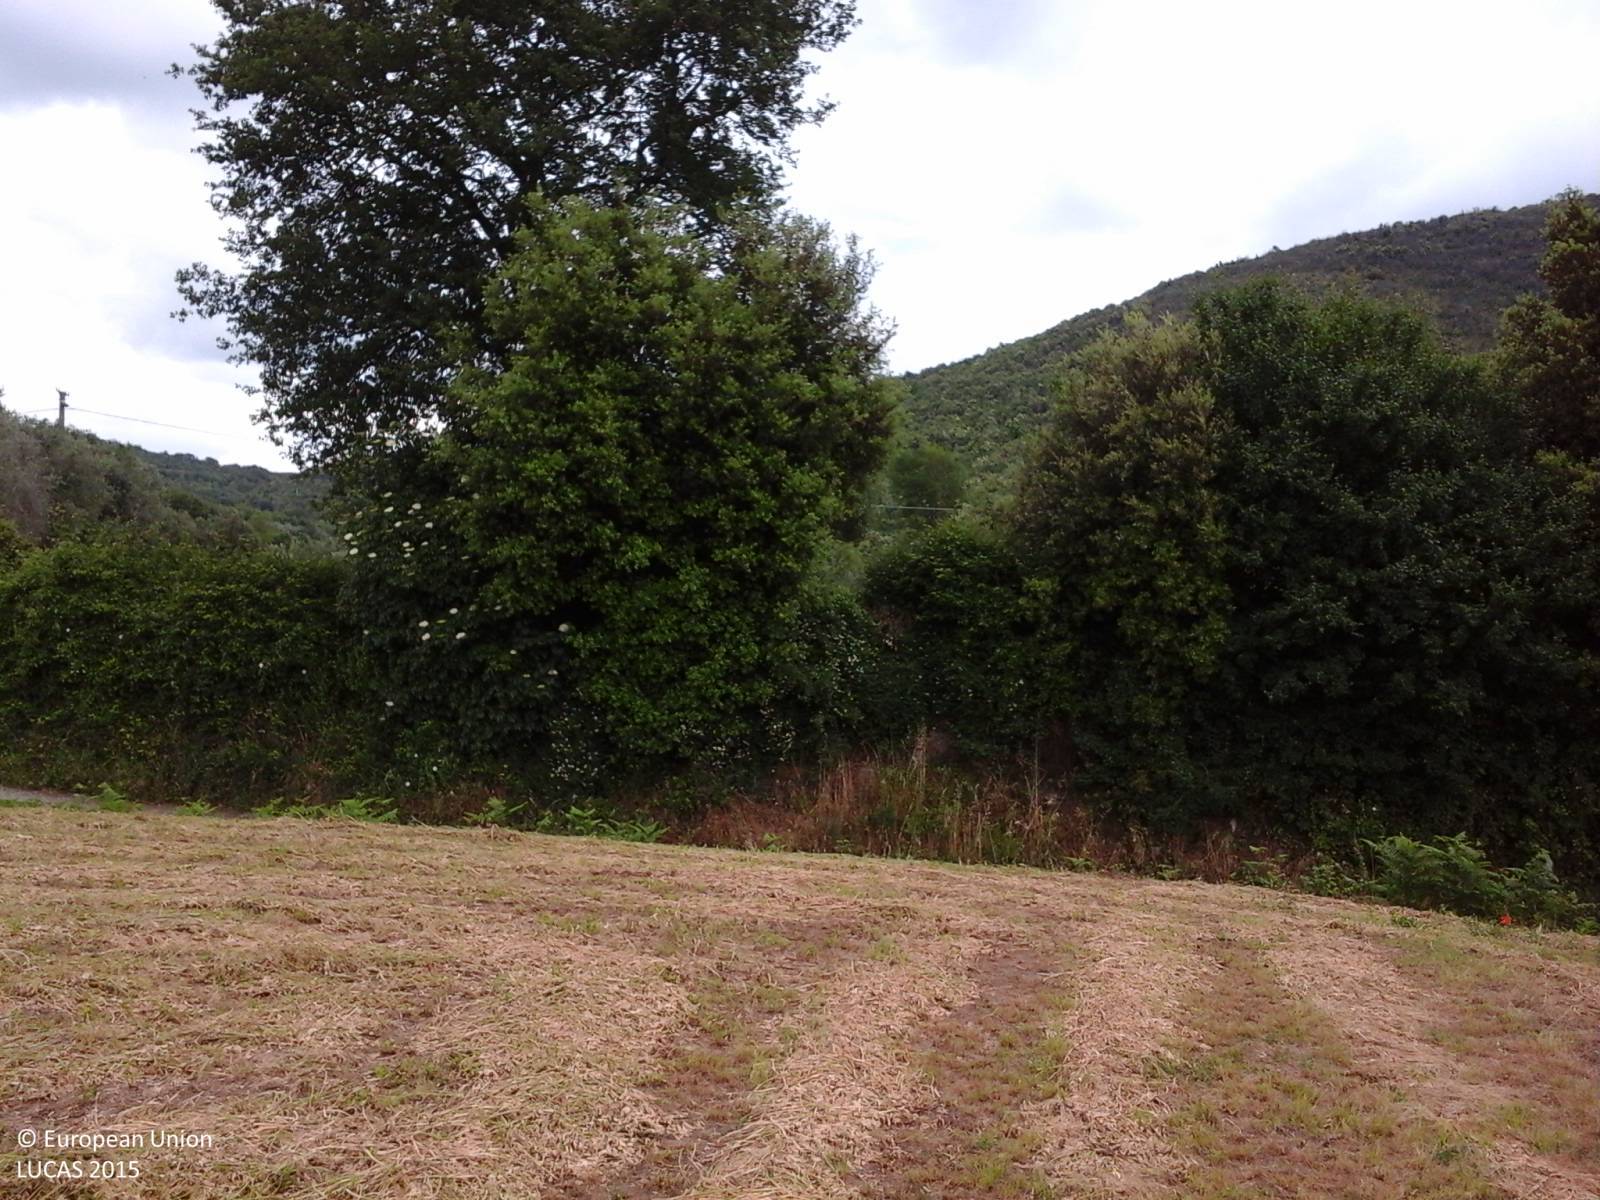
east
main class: Cropland
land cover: Lucerne
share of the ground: > 75 %
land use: Agriculture (excluding fallow land and kitchen gardens)
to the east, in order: Lucerne; Grass margins; Ditches and canals; Grass margins; Tracks; Abandoned hedges; Artificial constructions; Temporary grasslands; Electric lines; Temporary grasslands; Abandoned hedges; Vineyards; Olive groves; Grass margins; Olive groves; Broadleaved woodland
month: May
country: IT
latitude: 41.1891
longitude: 14.2636
